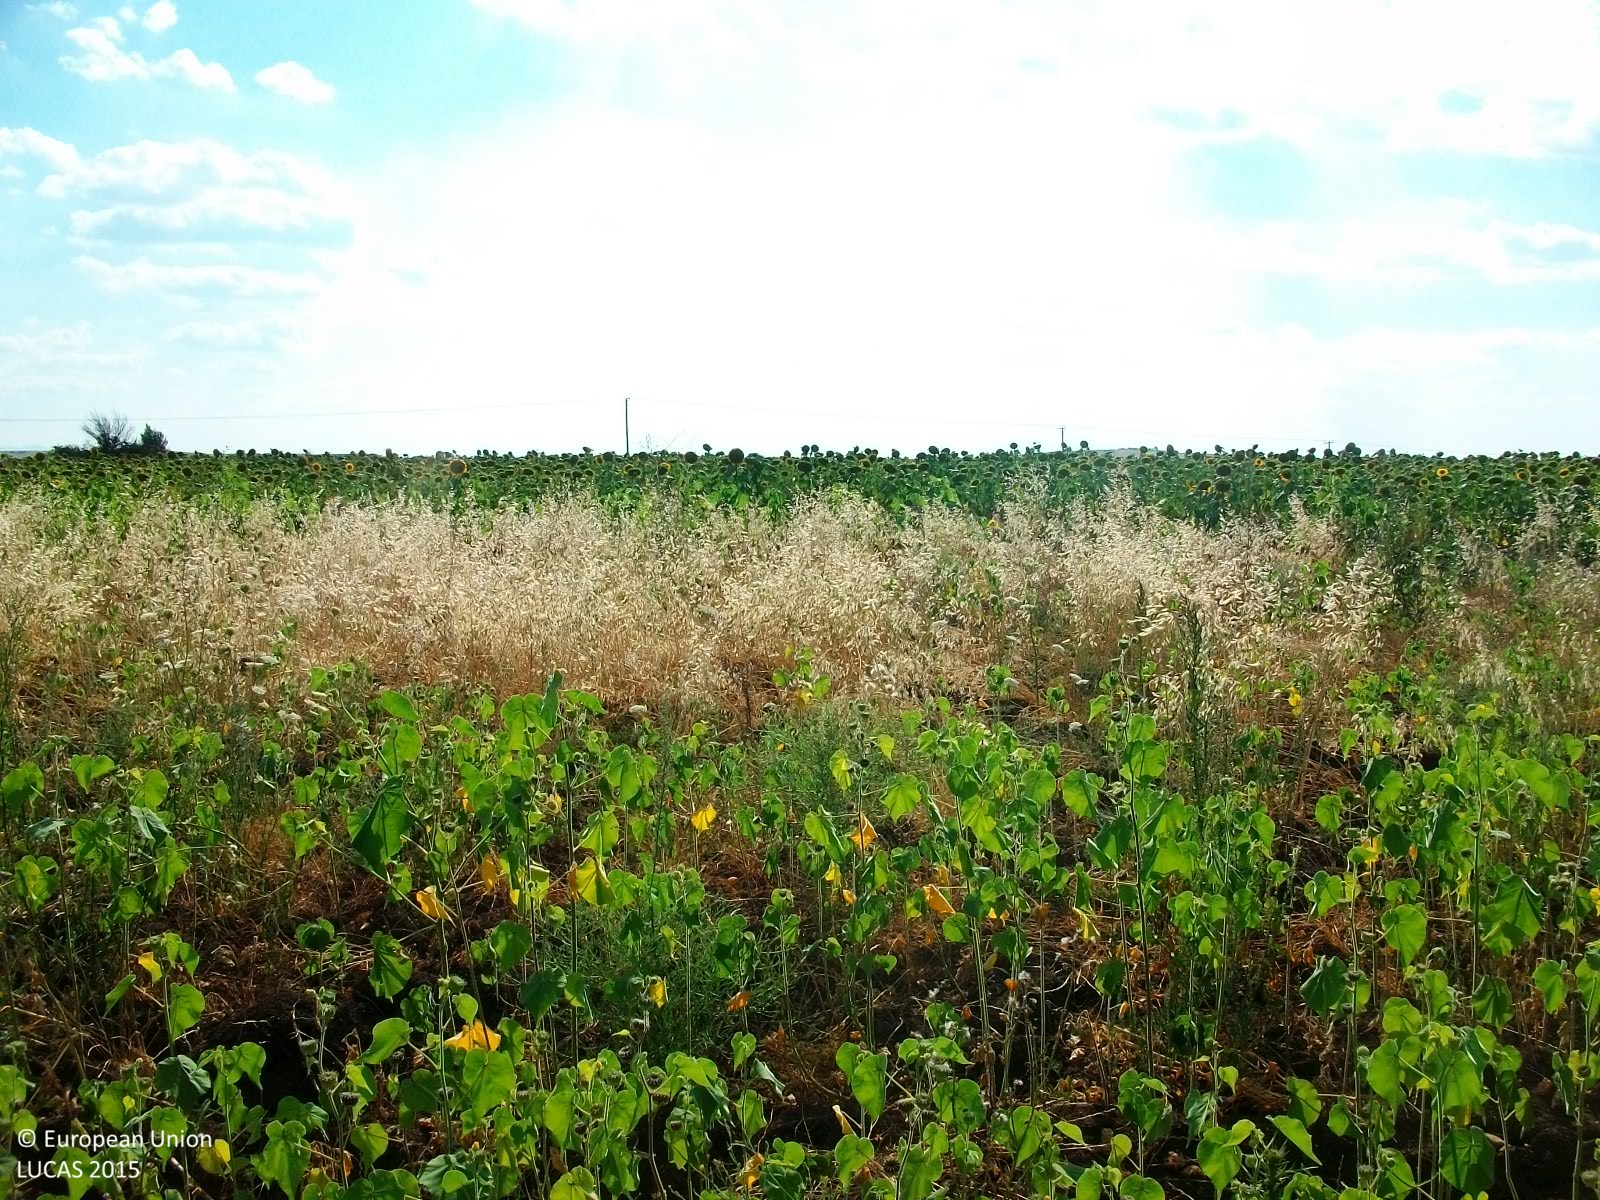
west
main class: Cropland
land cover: Sunflower
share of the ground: > 75 %
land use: Agriculture (excluding fallow land and kitchen gardens)
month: July
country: GR
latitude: 41.5586
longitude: 26.3224
